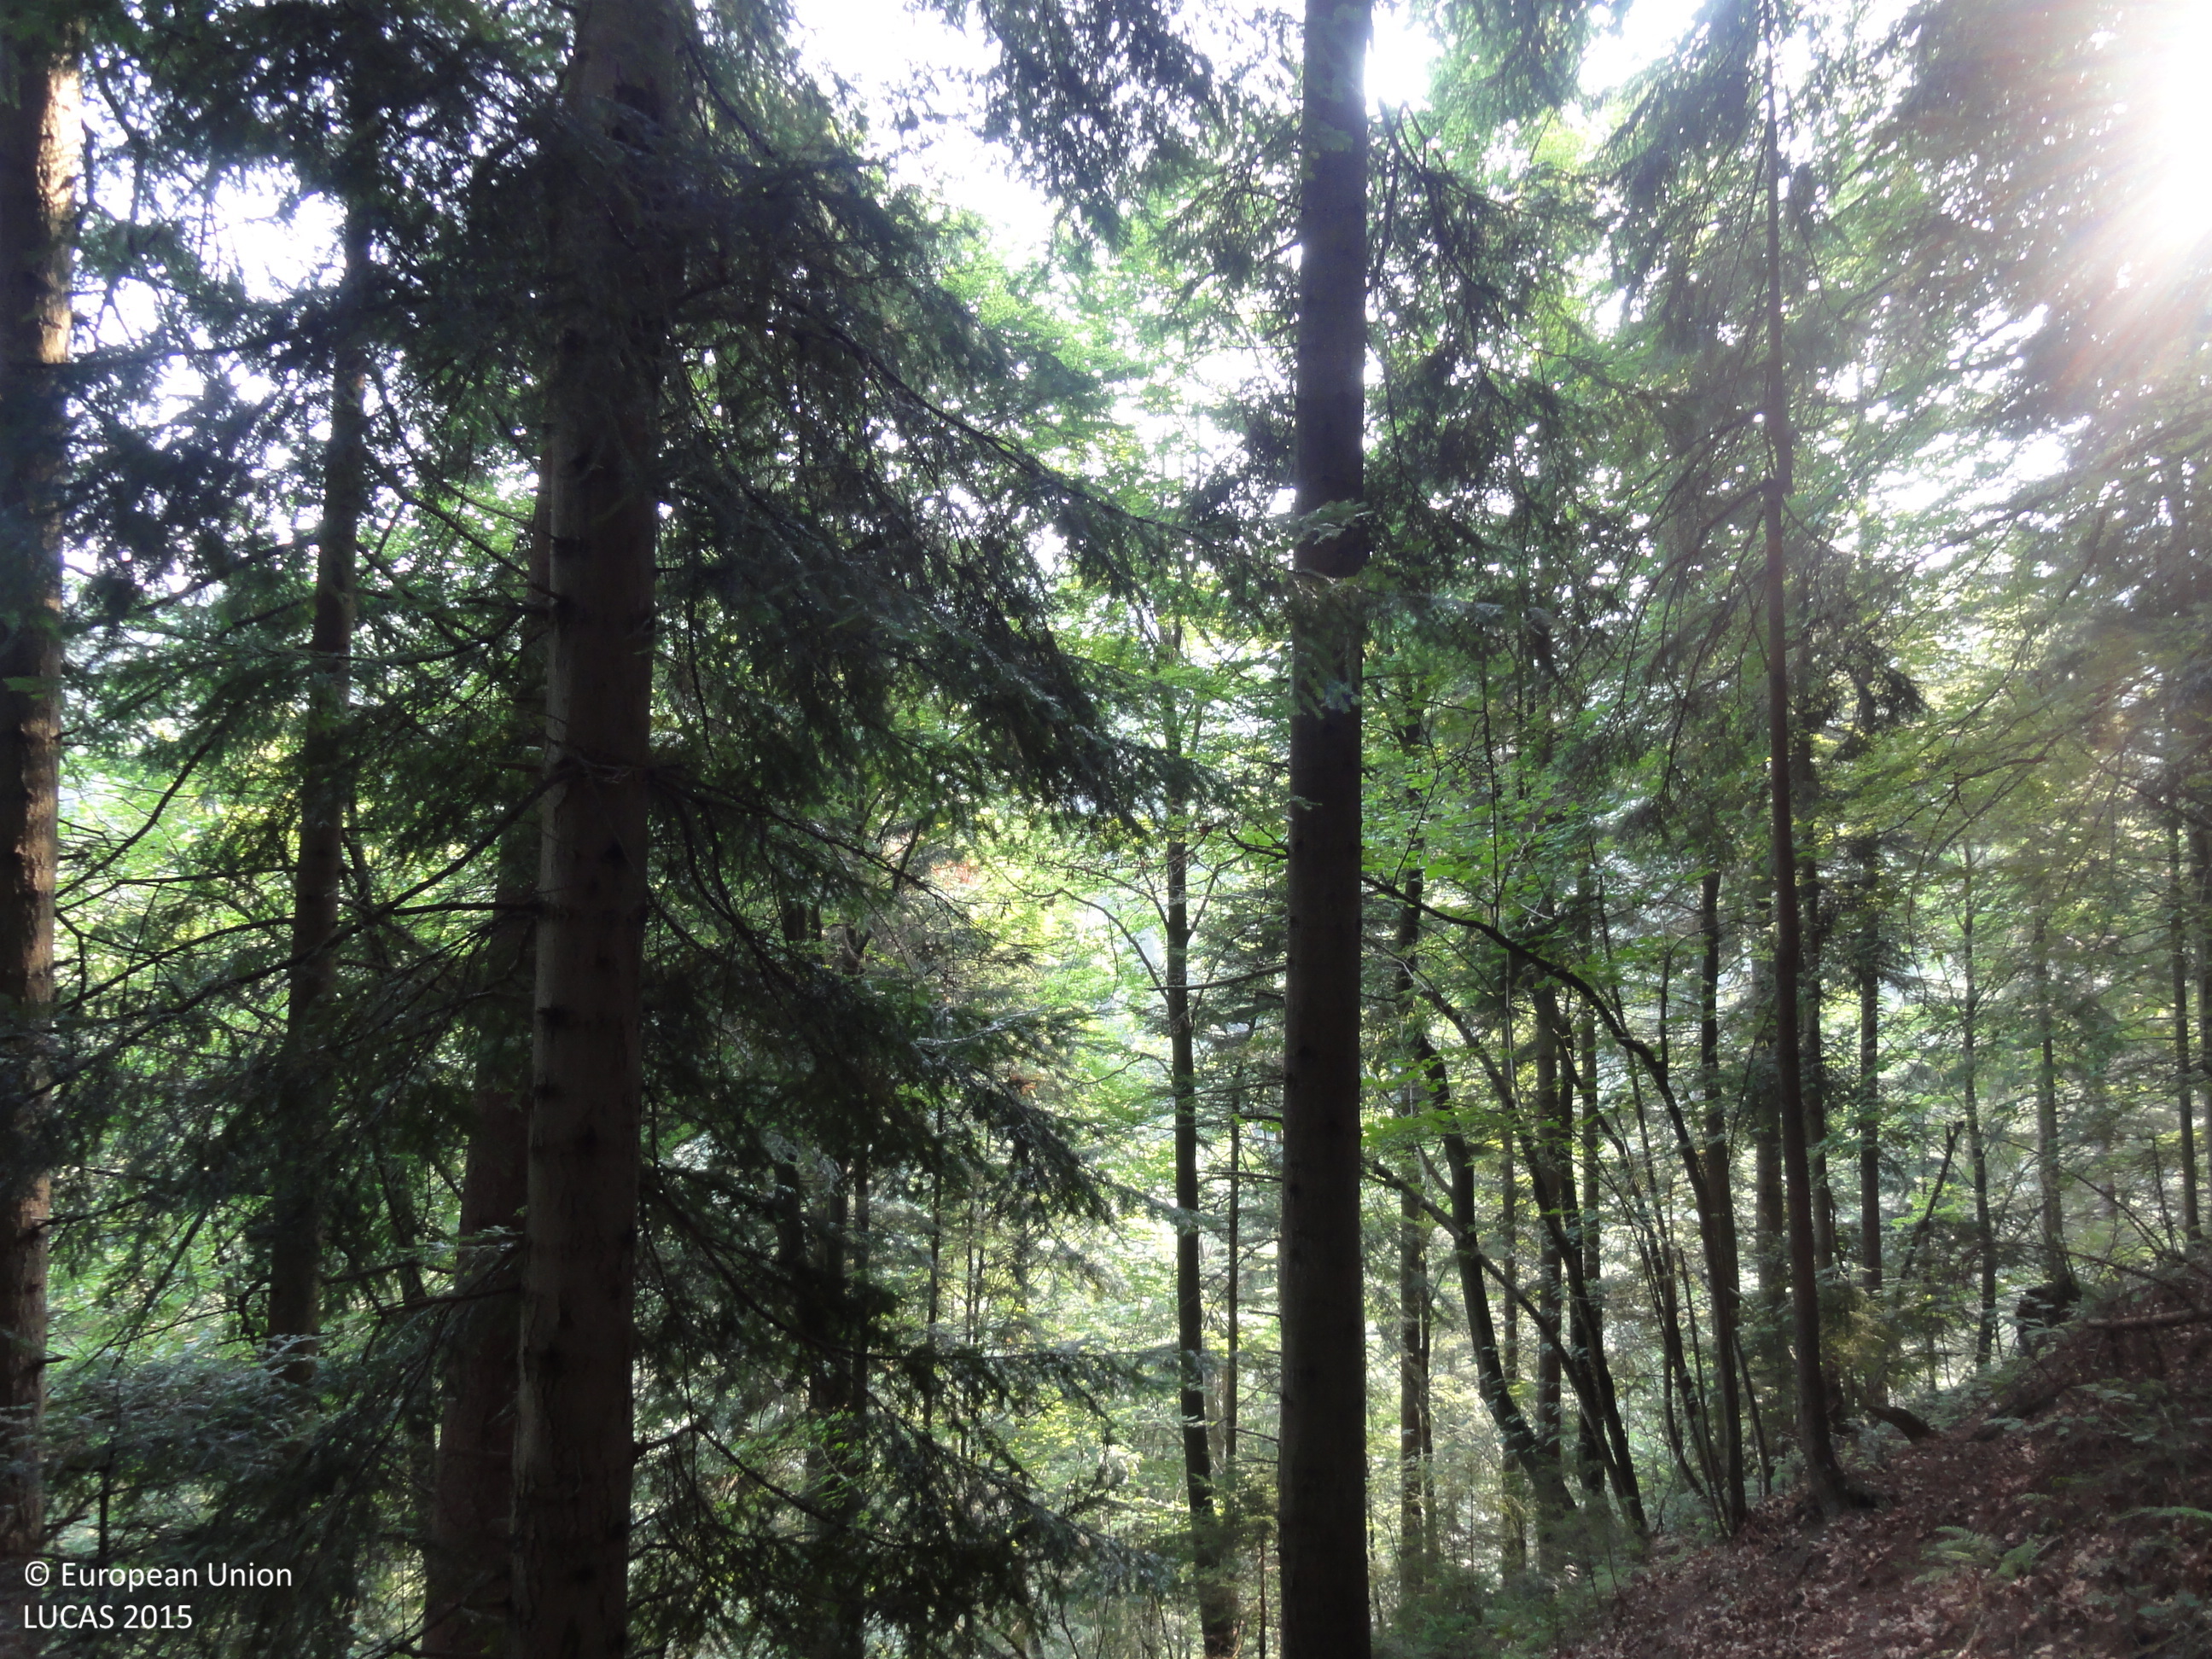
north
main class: Woodland
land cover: Spruce dominated mixed woodland
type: mountainous beech forest
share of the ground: > 75 %
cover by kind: coniferous forest trees 65 %, broadleaved forest trees 35 %
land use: Forestry
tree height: > 5 m
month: July
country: SI
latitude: 46.5532
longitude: 15.1241
